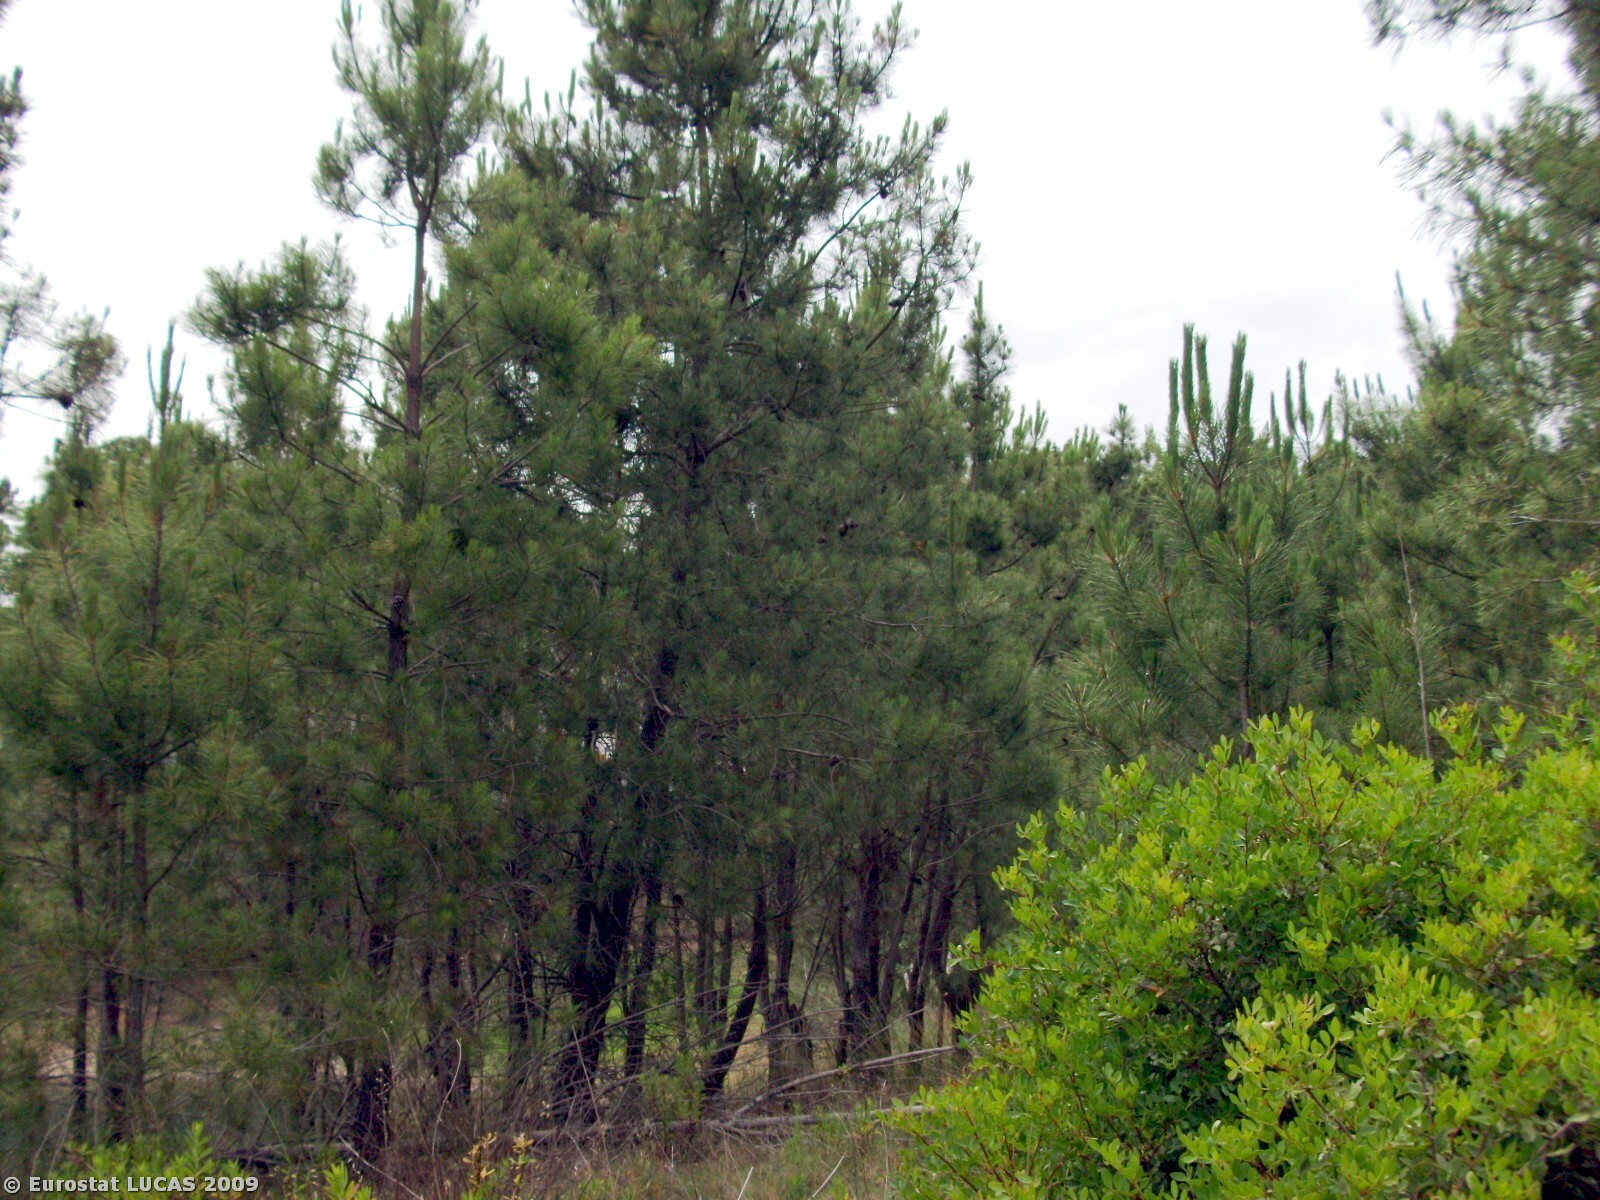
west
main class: Woodland
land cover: Coniferous woodland
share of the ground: 25 - 50 %
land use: Amenities, museums, leisure
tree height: > 5 m
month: June
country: PT
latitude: 39.5680
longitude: -8.2850
